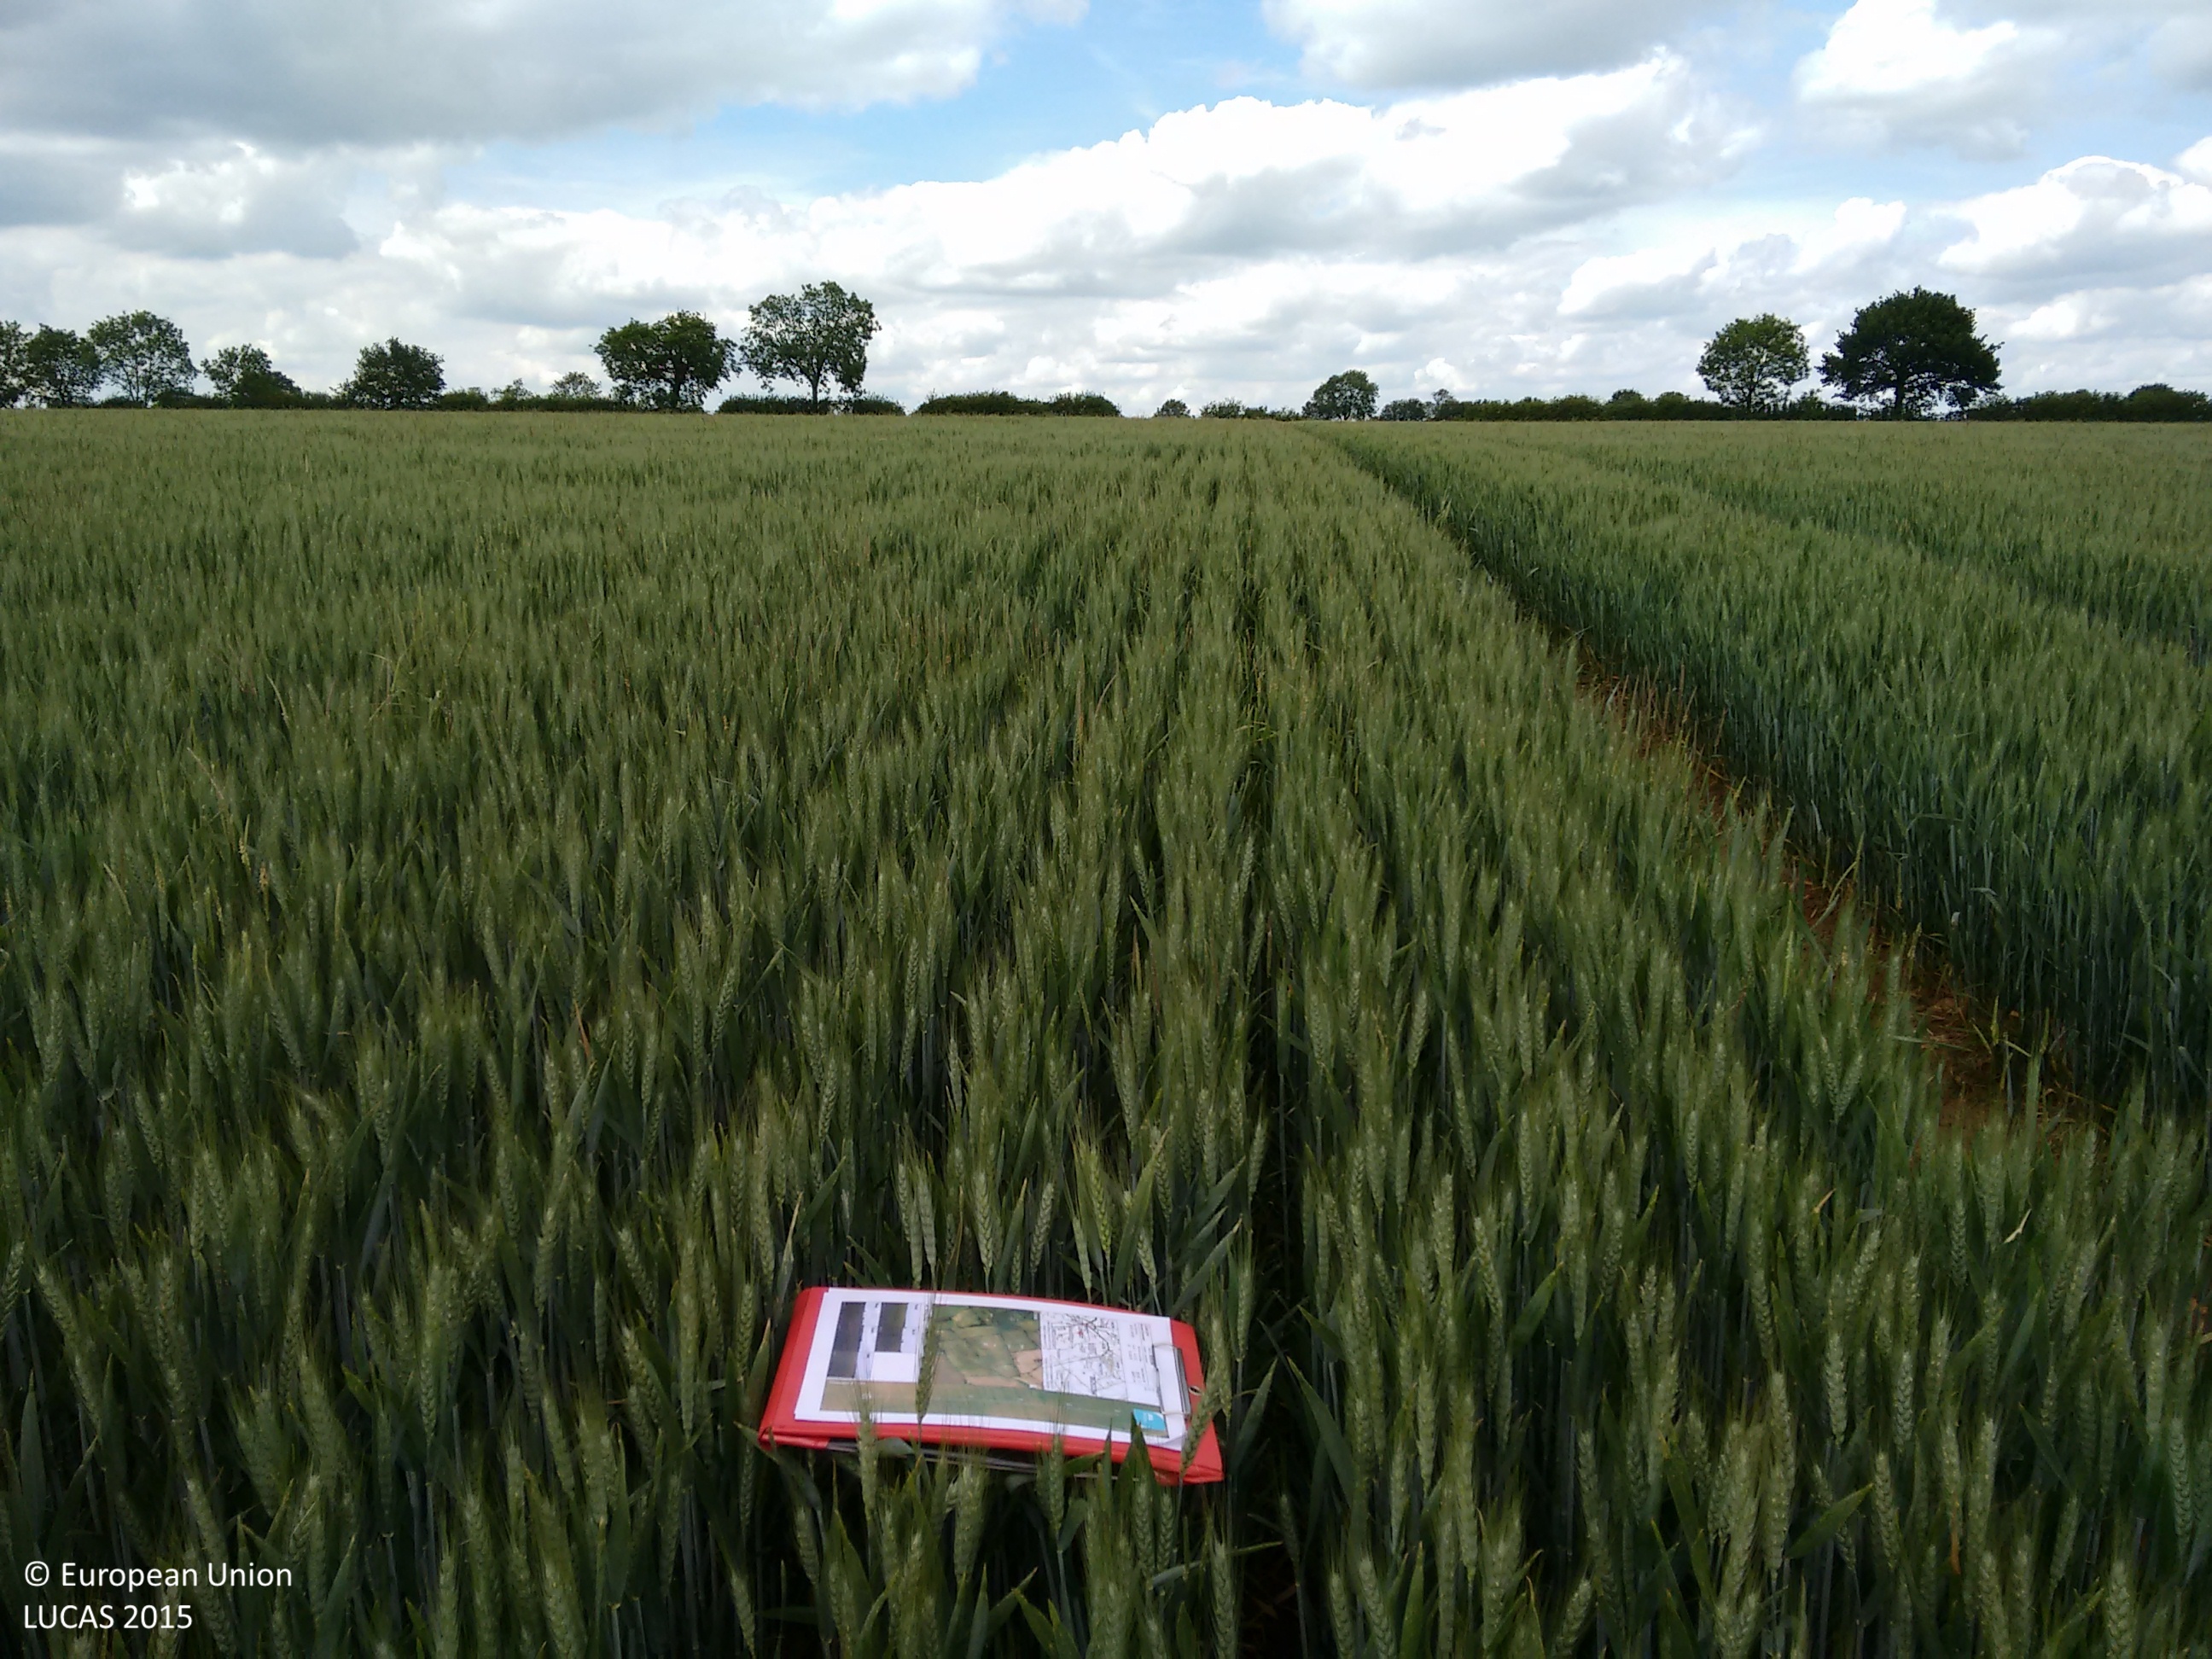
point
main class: Cropland
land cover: Common wheat
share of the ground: > 75 %
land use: Agriculture (excluding fallow land and kitchen gardens)
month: June
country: GB
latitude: 53.2031
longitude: -0.4417
